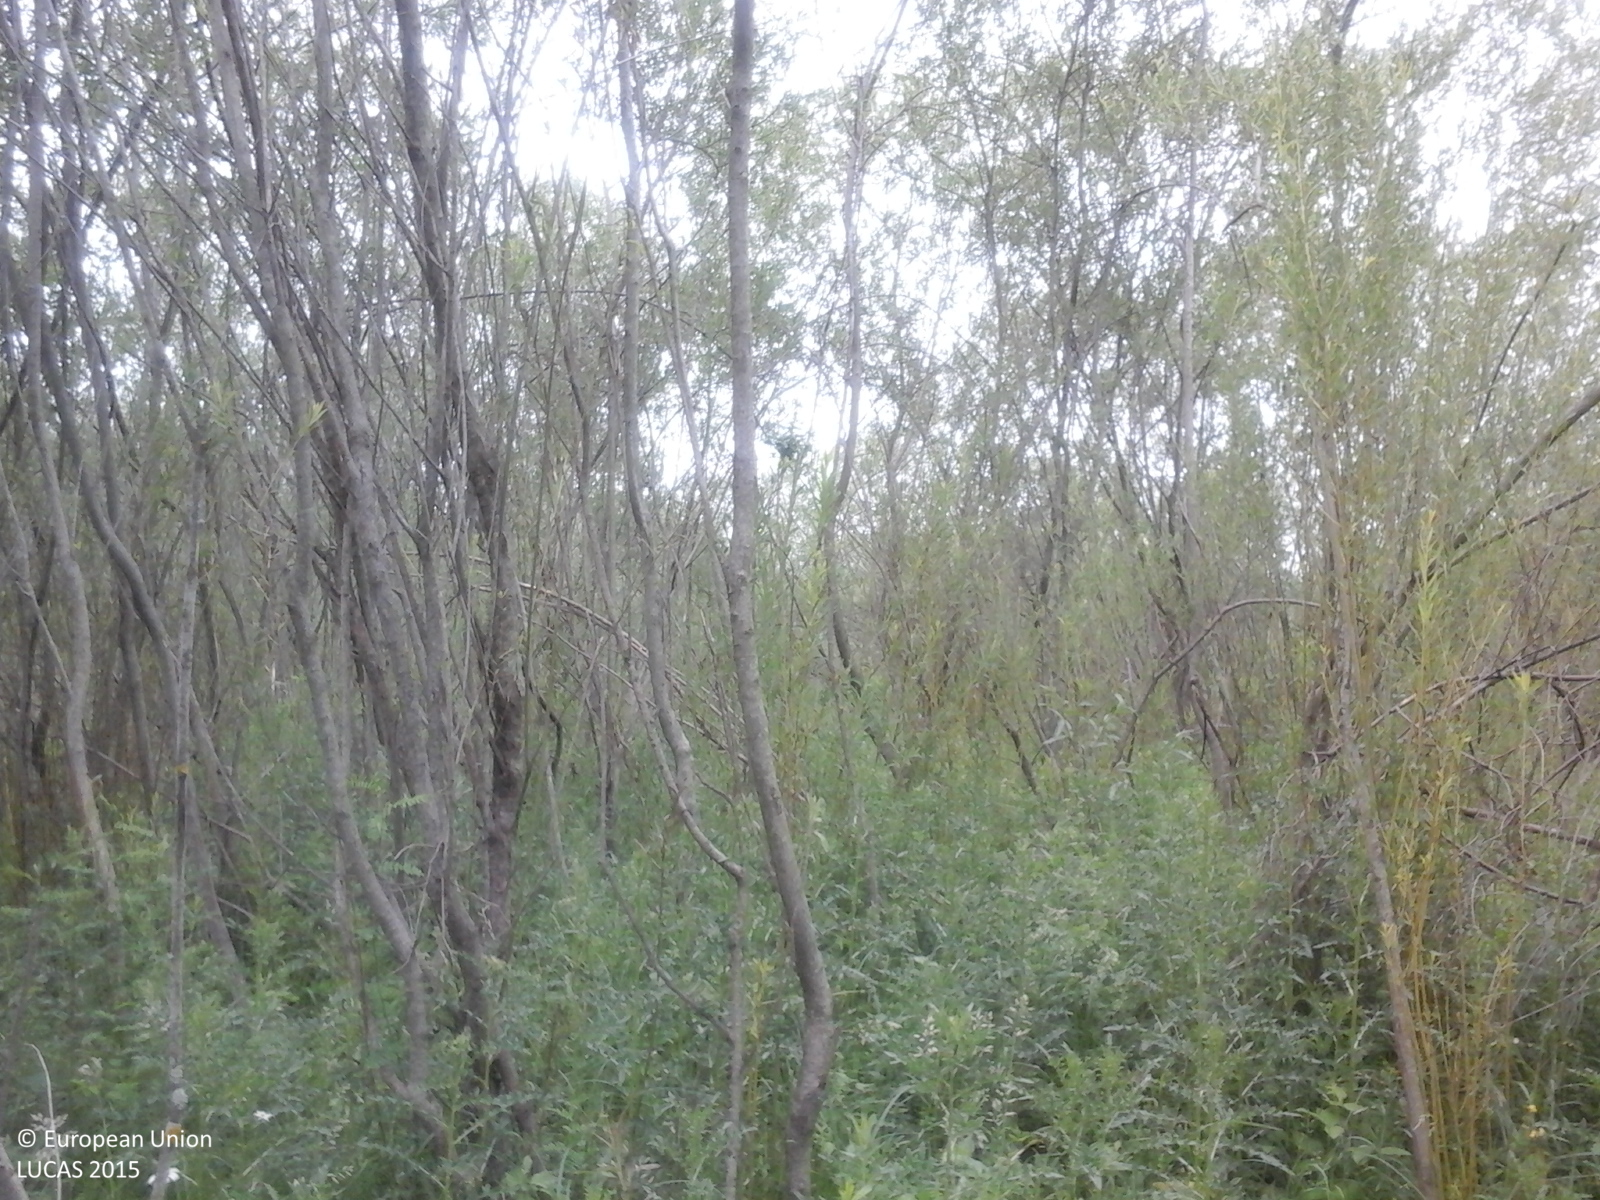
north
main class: Woodland
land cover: Broadleaved woodland
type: thermophilous deciduous forest
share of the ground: > 75 %
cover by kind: broadleaved forest trees 85 %, herbaceous plants 15 %
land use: Semi-natural and natural areas not in use
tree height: > 5 m
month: June
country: RO
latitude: 47.9163
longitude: 25.6856
